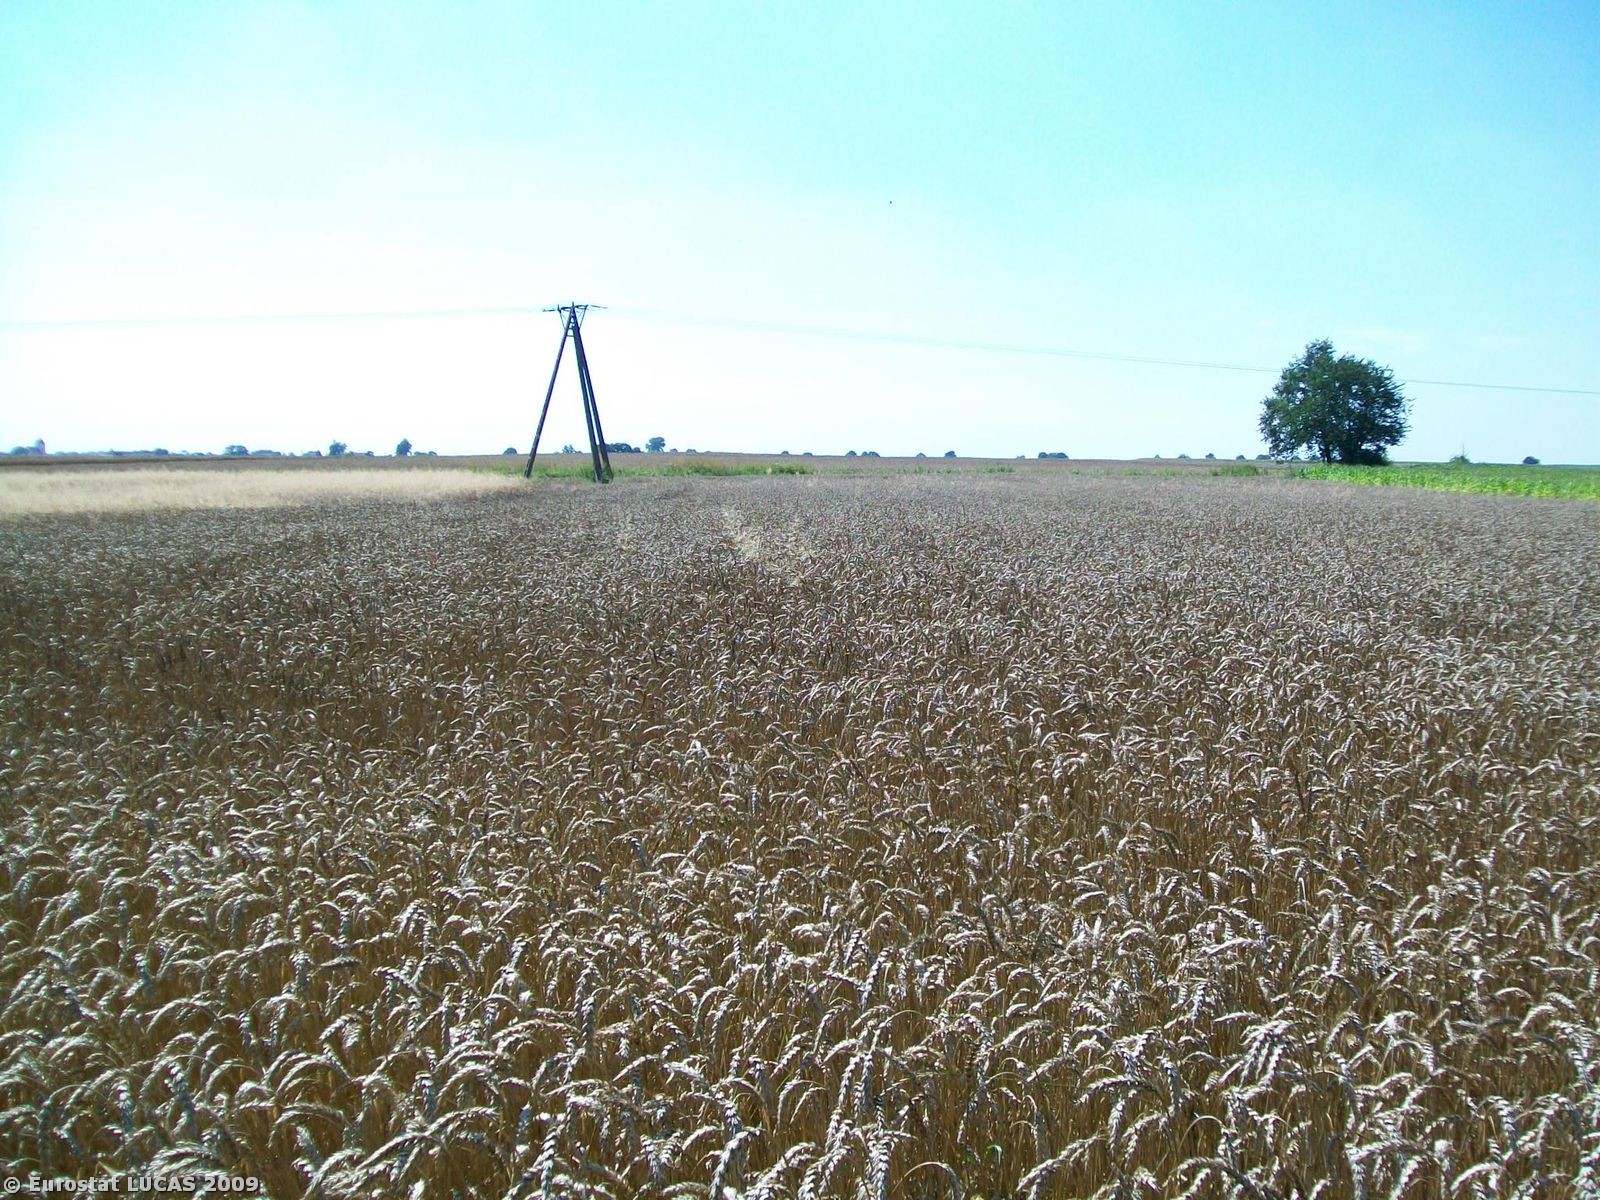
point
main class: Cropland
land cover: Common wheat
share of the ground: > 75 %
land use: Agriculture (excluding fallow land and kitchen gardens)
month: August
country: PL
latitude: 51.0484
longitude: 16.7561
